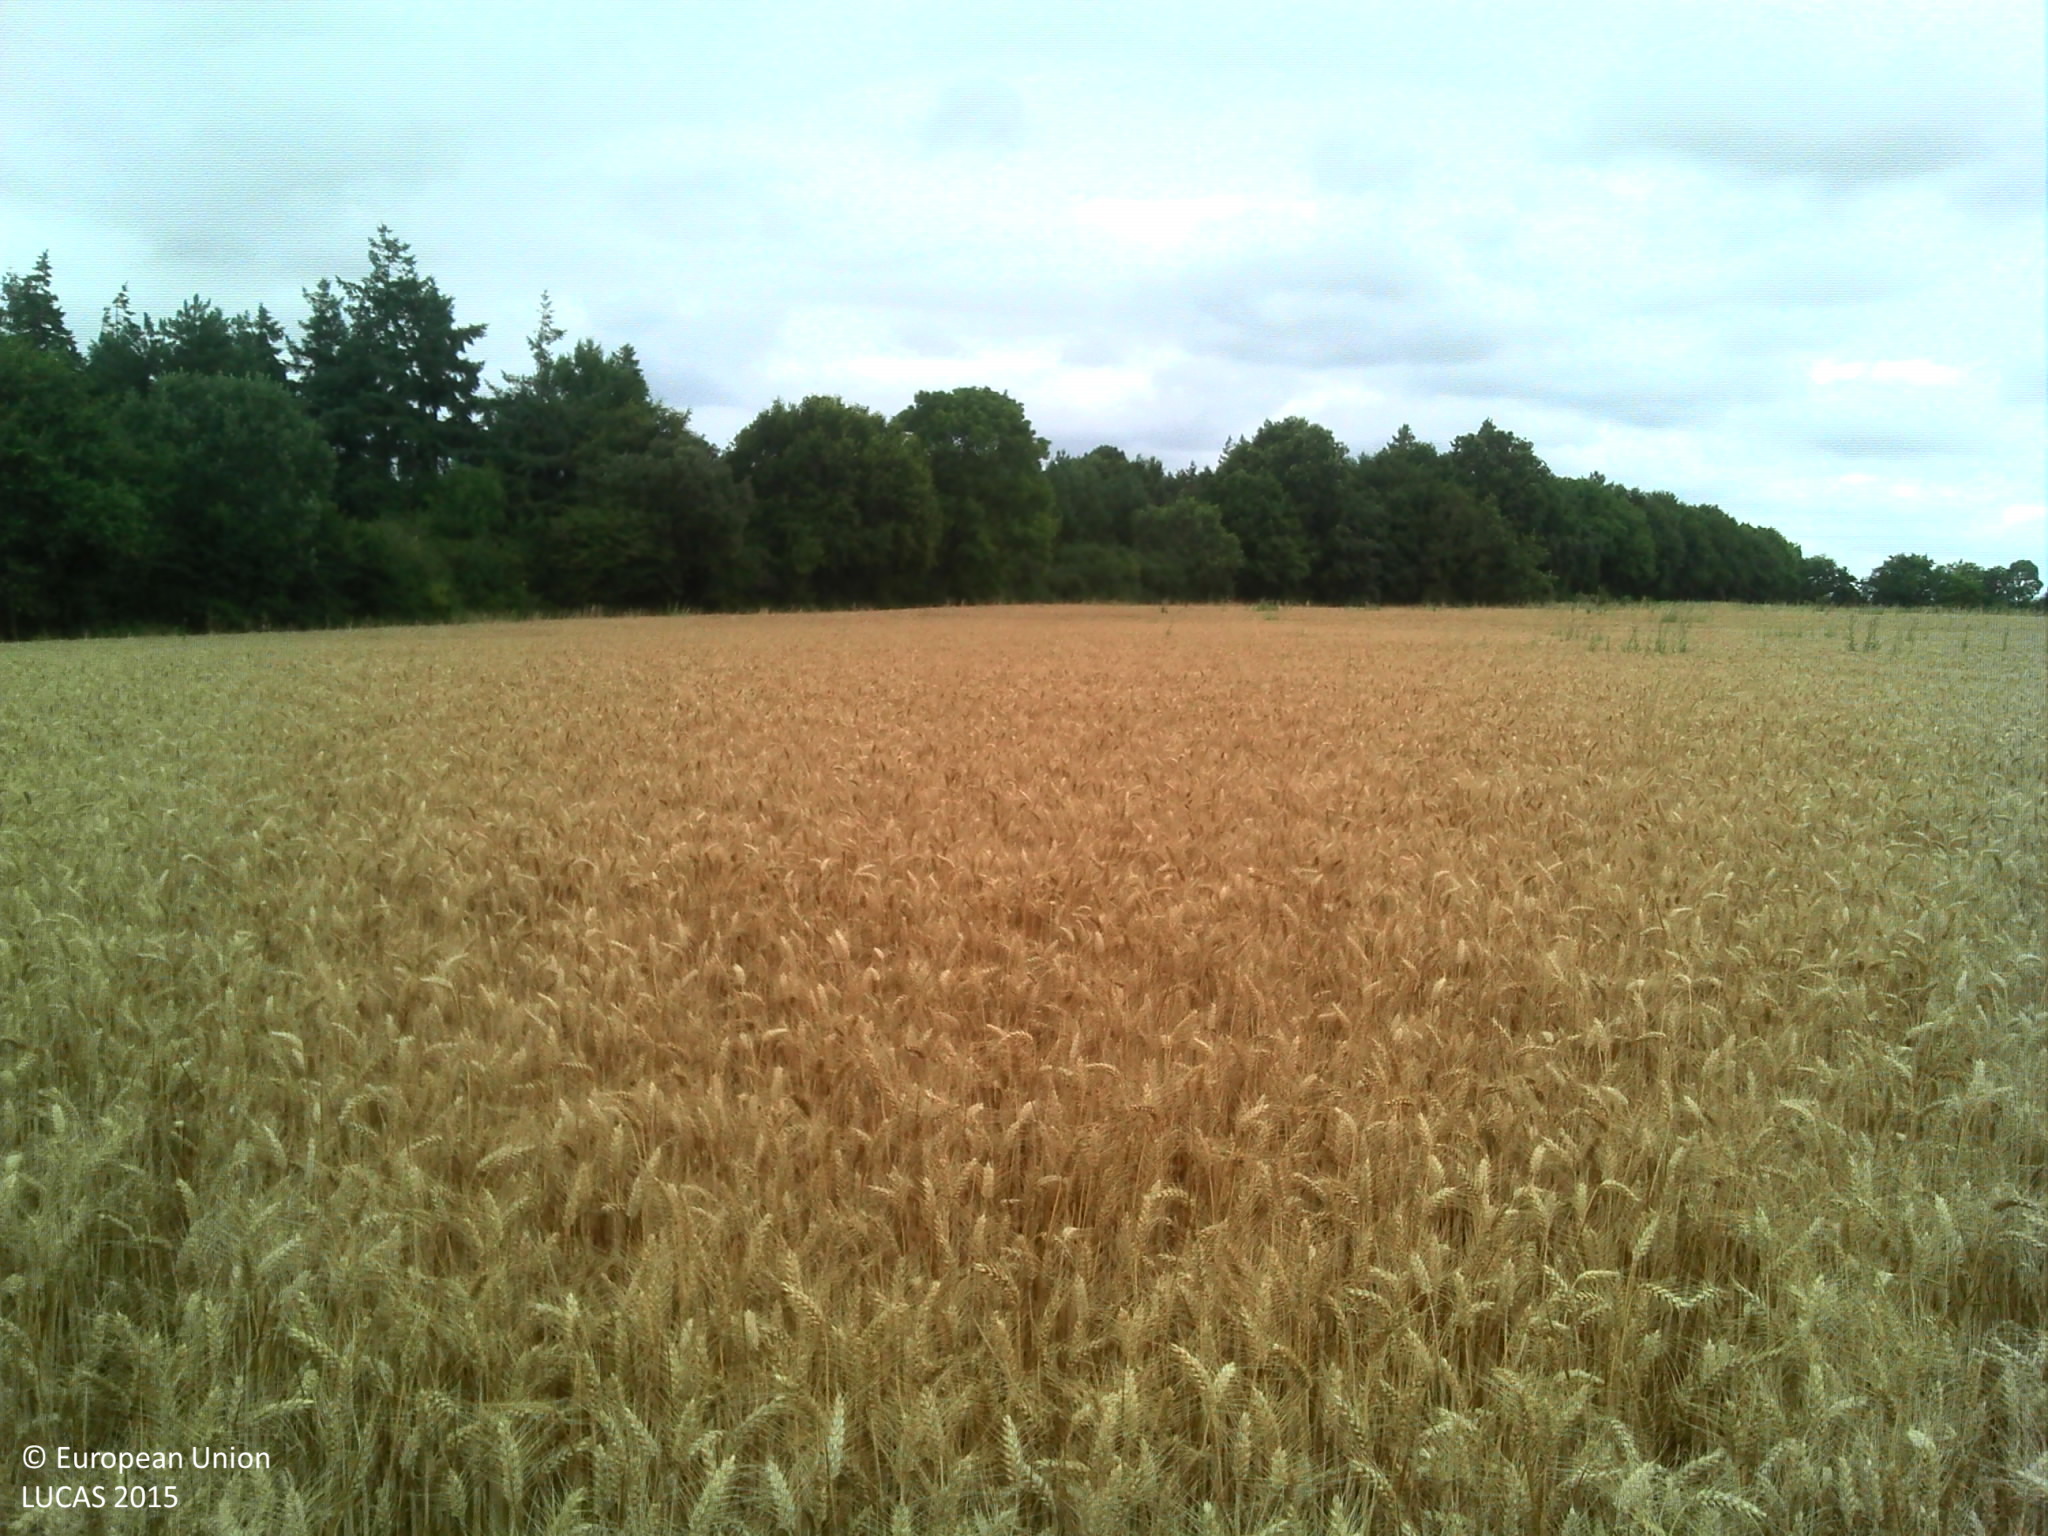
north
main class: Cropland
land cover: Common wheat
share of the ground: > 75 %
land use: Agriculture (excluding fallow land and kitchen gardens)
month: July
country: FR
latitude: 46.4824
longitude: -1.5930
